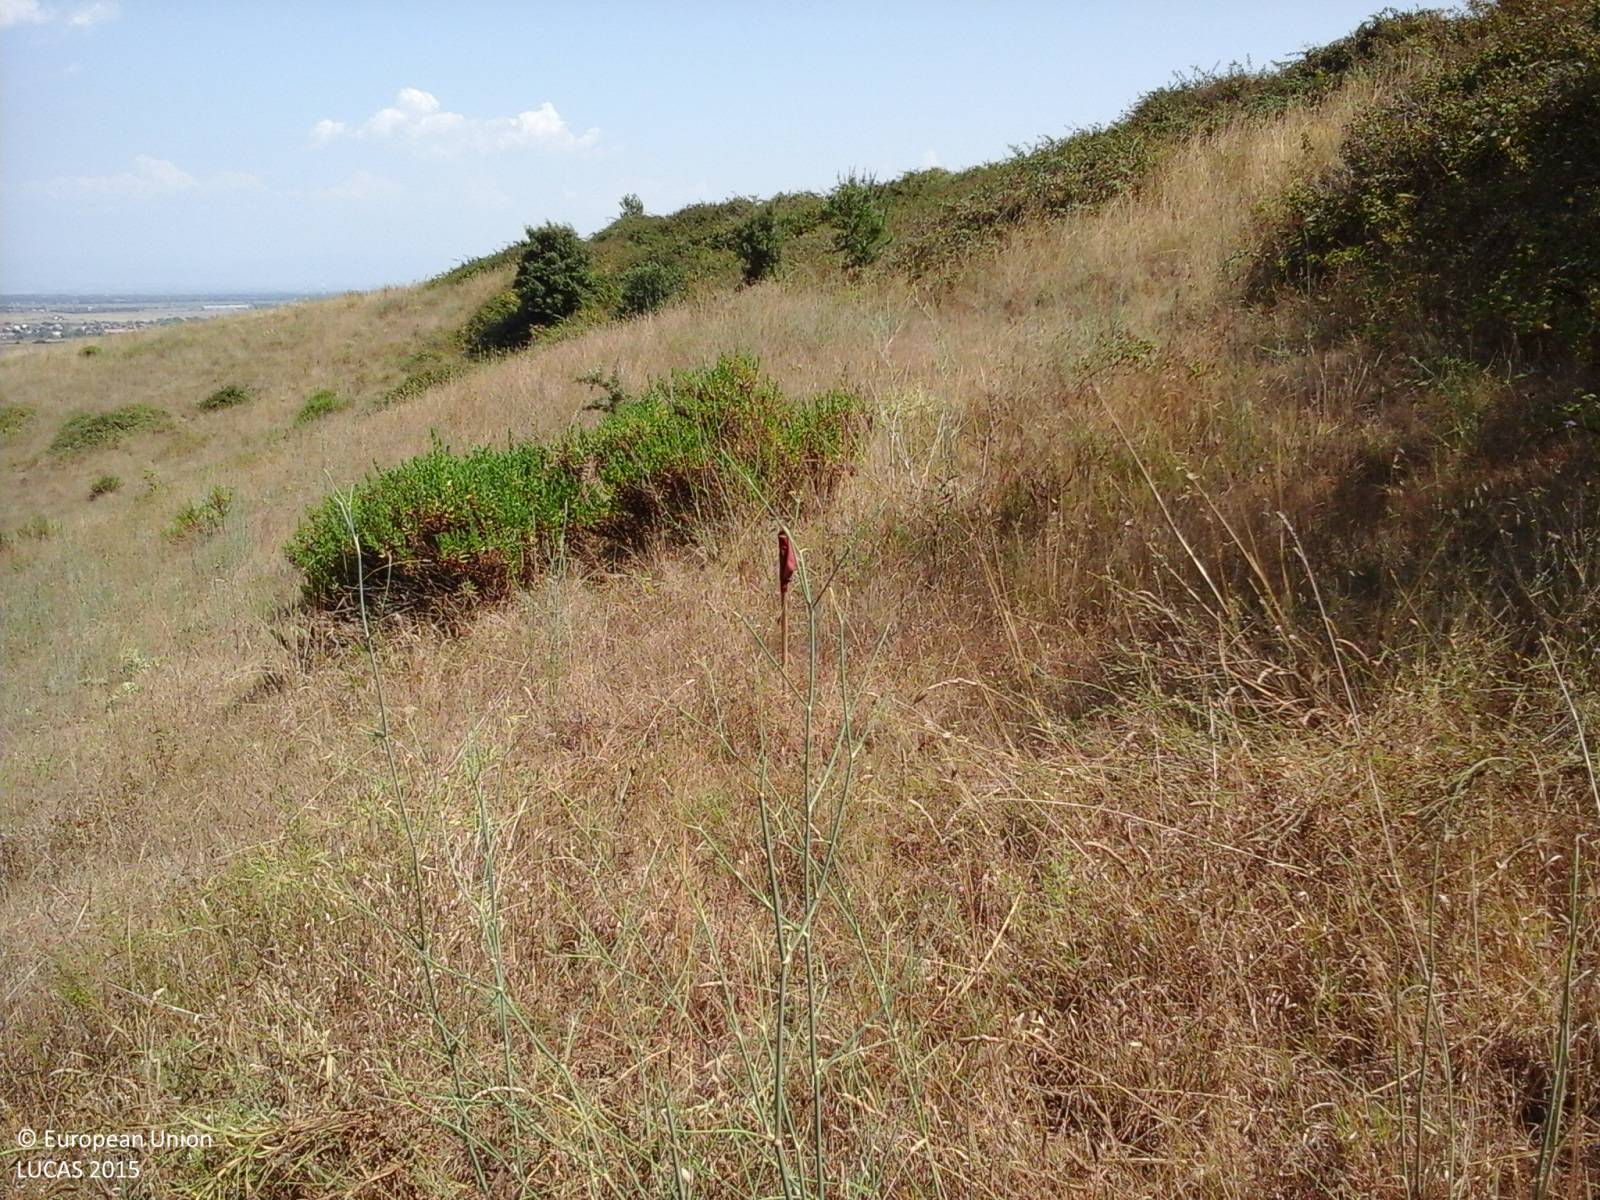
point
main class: Grassland
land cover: Grassland without tree/shrub cover
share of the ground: > 75 %
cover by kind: herbaceous plants 100 %
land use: Agriculture (excluding fallow land and kitchen gardens)
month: August
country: IT
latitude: 42.0688
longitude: 12.2518
